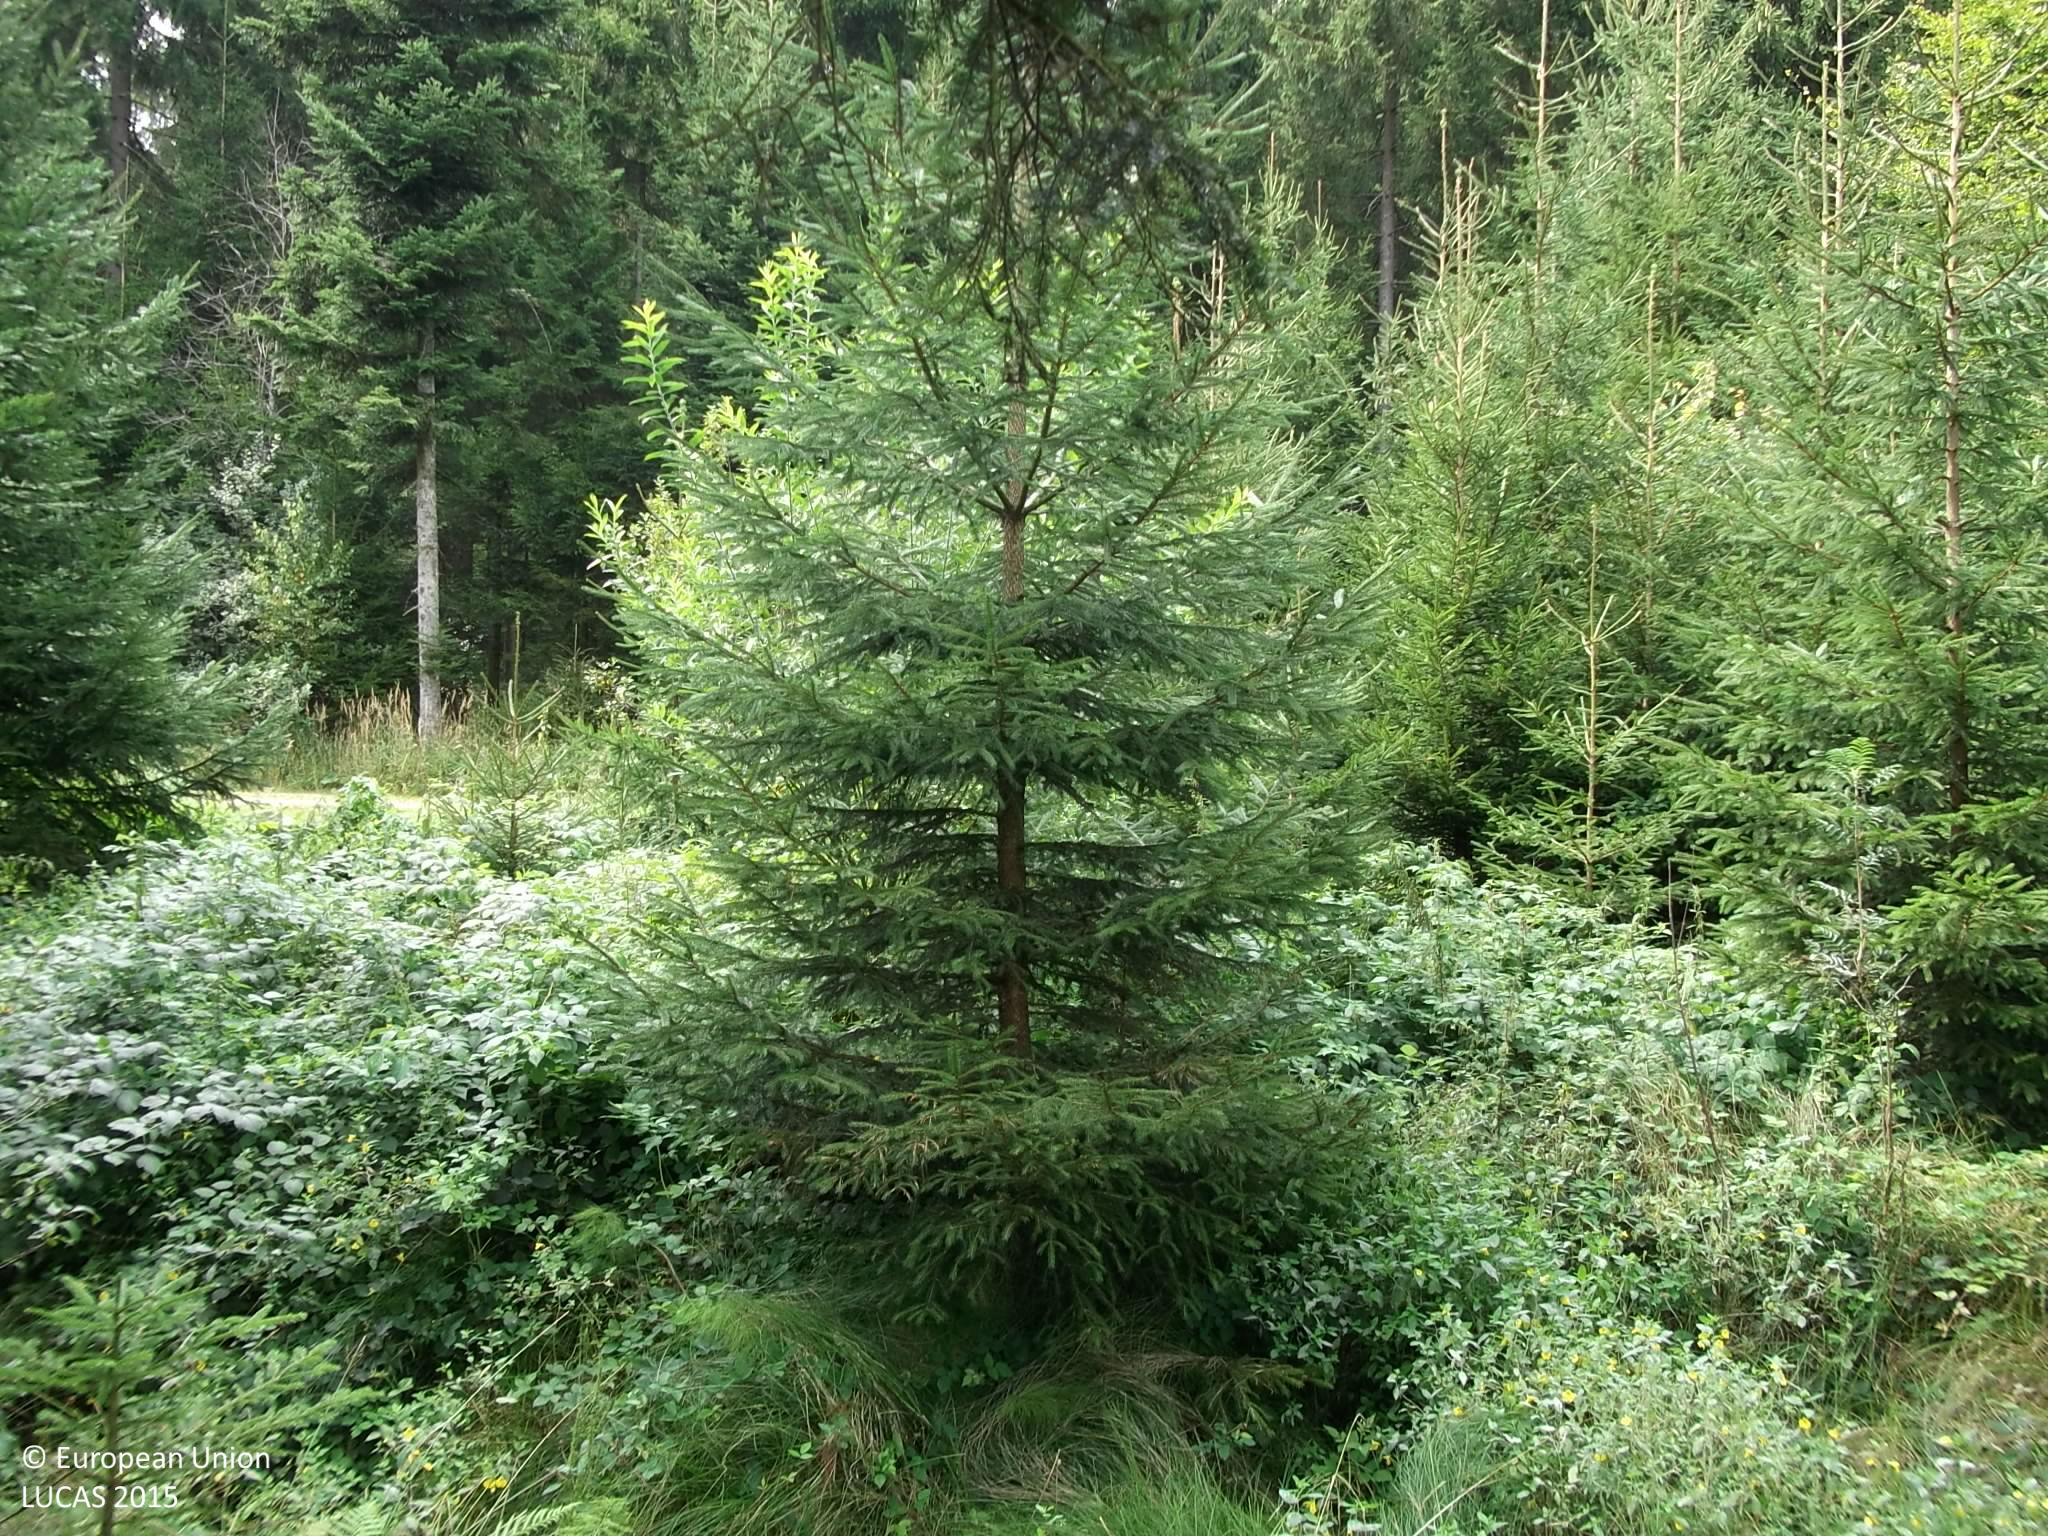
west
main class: Grassland
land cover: Grassland with sparse tree/shrub cover
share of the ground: > 75 %
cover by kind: herbaceous plants 90 %, coniferous forest trees 5 %, shrubs 5 %
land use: Forestry
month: August
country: AT
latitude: 47.9742
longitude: 13.3613
